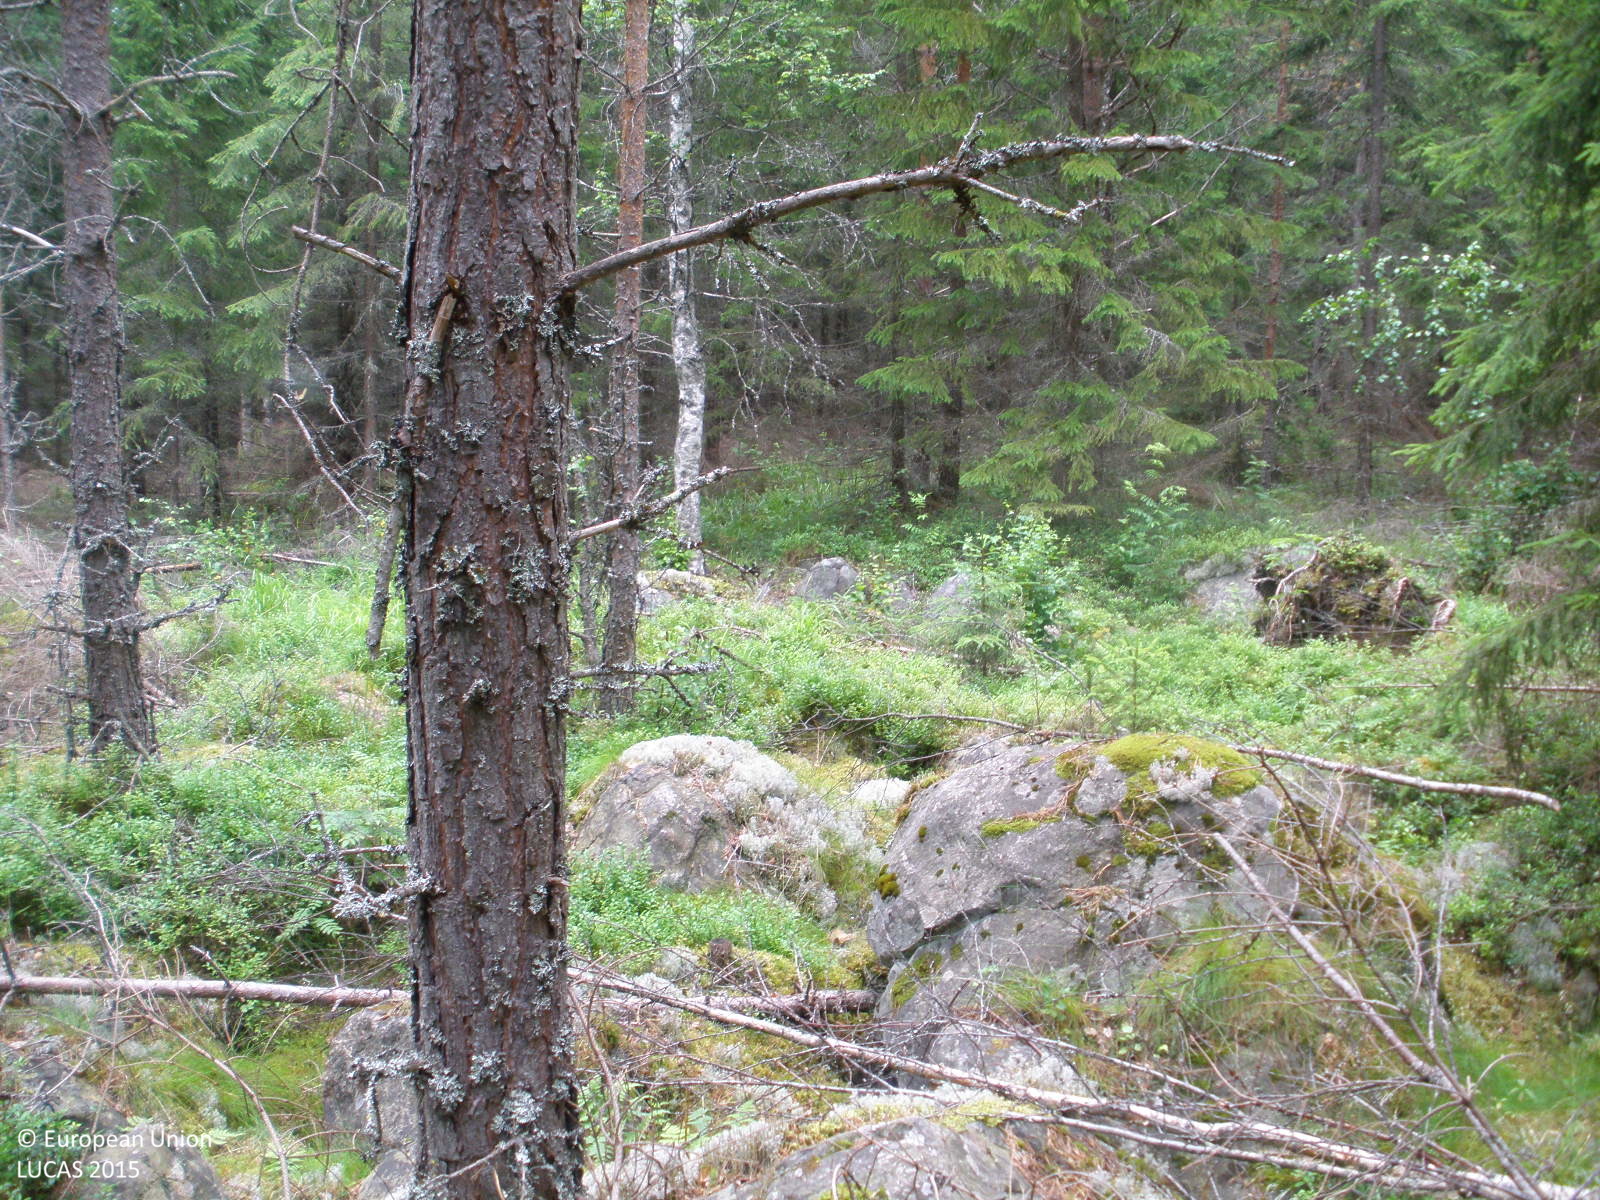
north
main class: Woodland
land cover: Spruce dominated coniferous woodland
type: boreal forest
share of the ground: > 75 %
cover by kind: coniferous forest trees 85 %, lichens and mosses 10 %, herbaceous plants 5 %
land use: Forestry
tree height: > 5 m
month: July
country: FI
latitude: 61.4551
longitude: 24.9475
